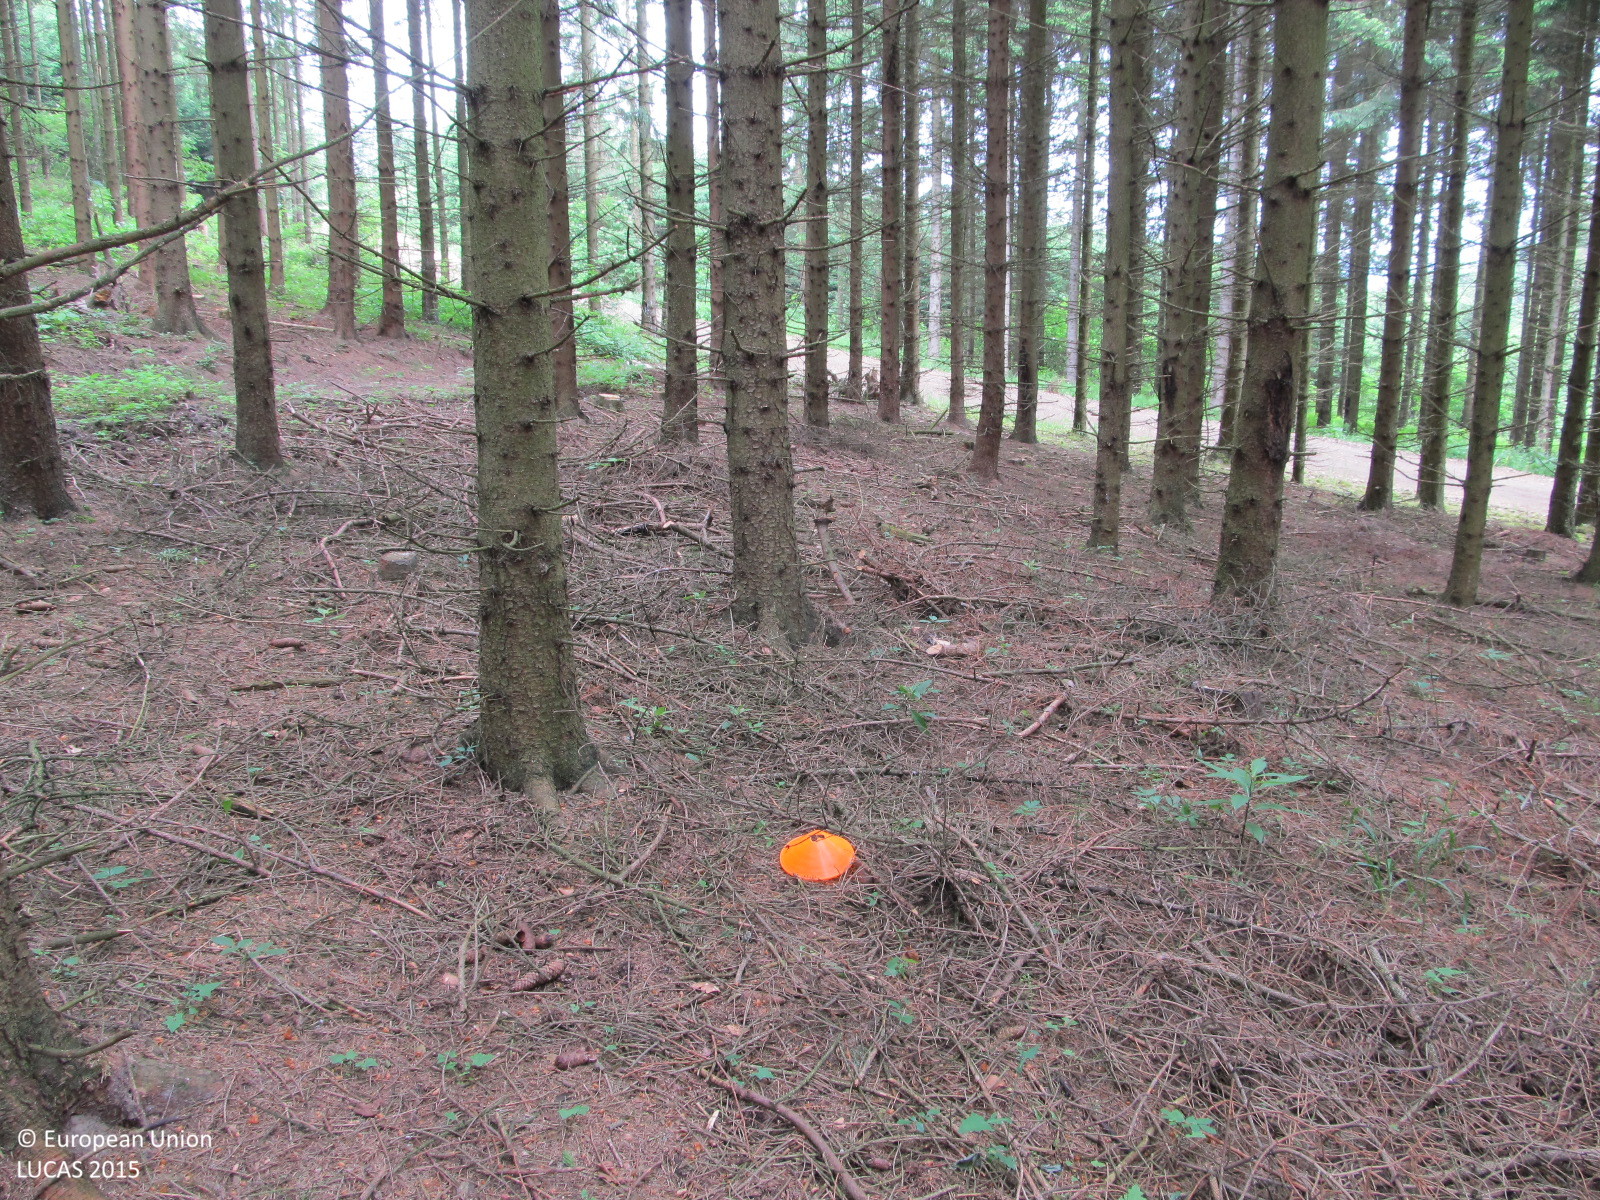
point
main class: Woodland
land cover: Spruce dominated coniferous woodland
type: hemiboreal forest and nemoral coniferous forest and mixed broadleaved-coniferous forest
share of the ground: > 75 %
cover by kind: coniferous forest trees 80 %, unconsolidated bare surface 20 %
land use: Forestry
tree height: > 5 m
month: June
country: AT
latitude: 48.5776
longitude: 15.4108
